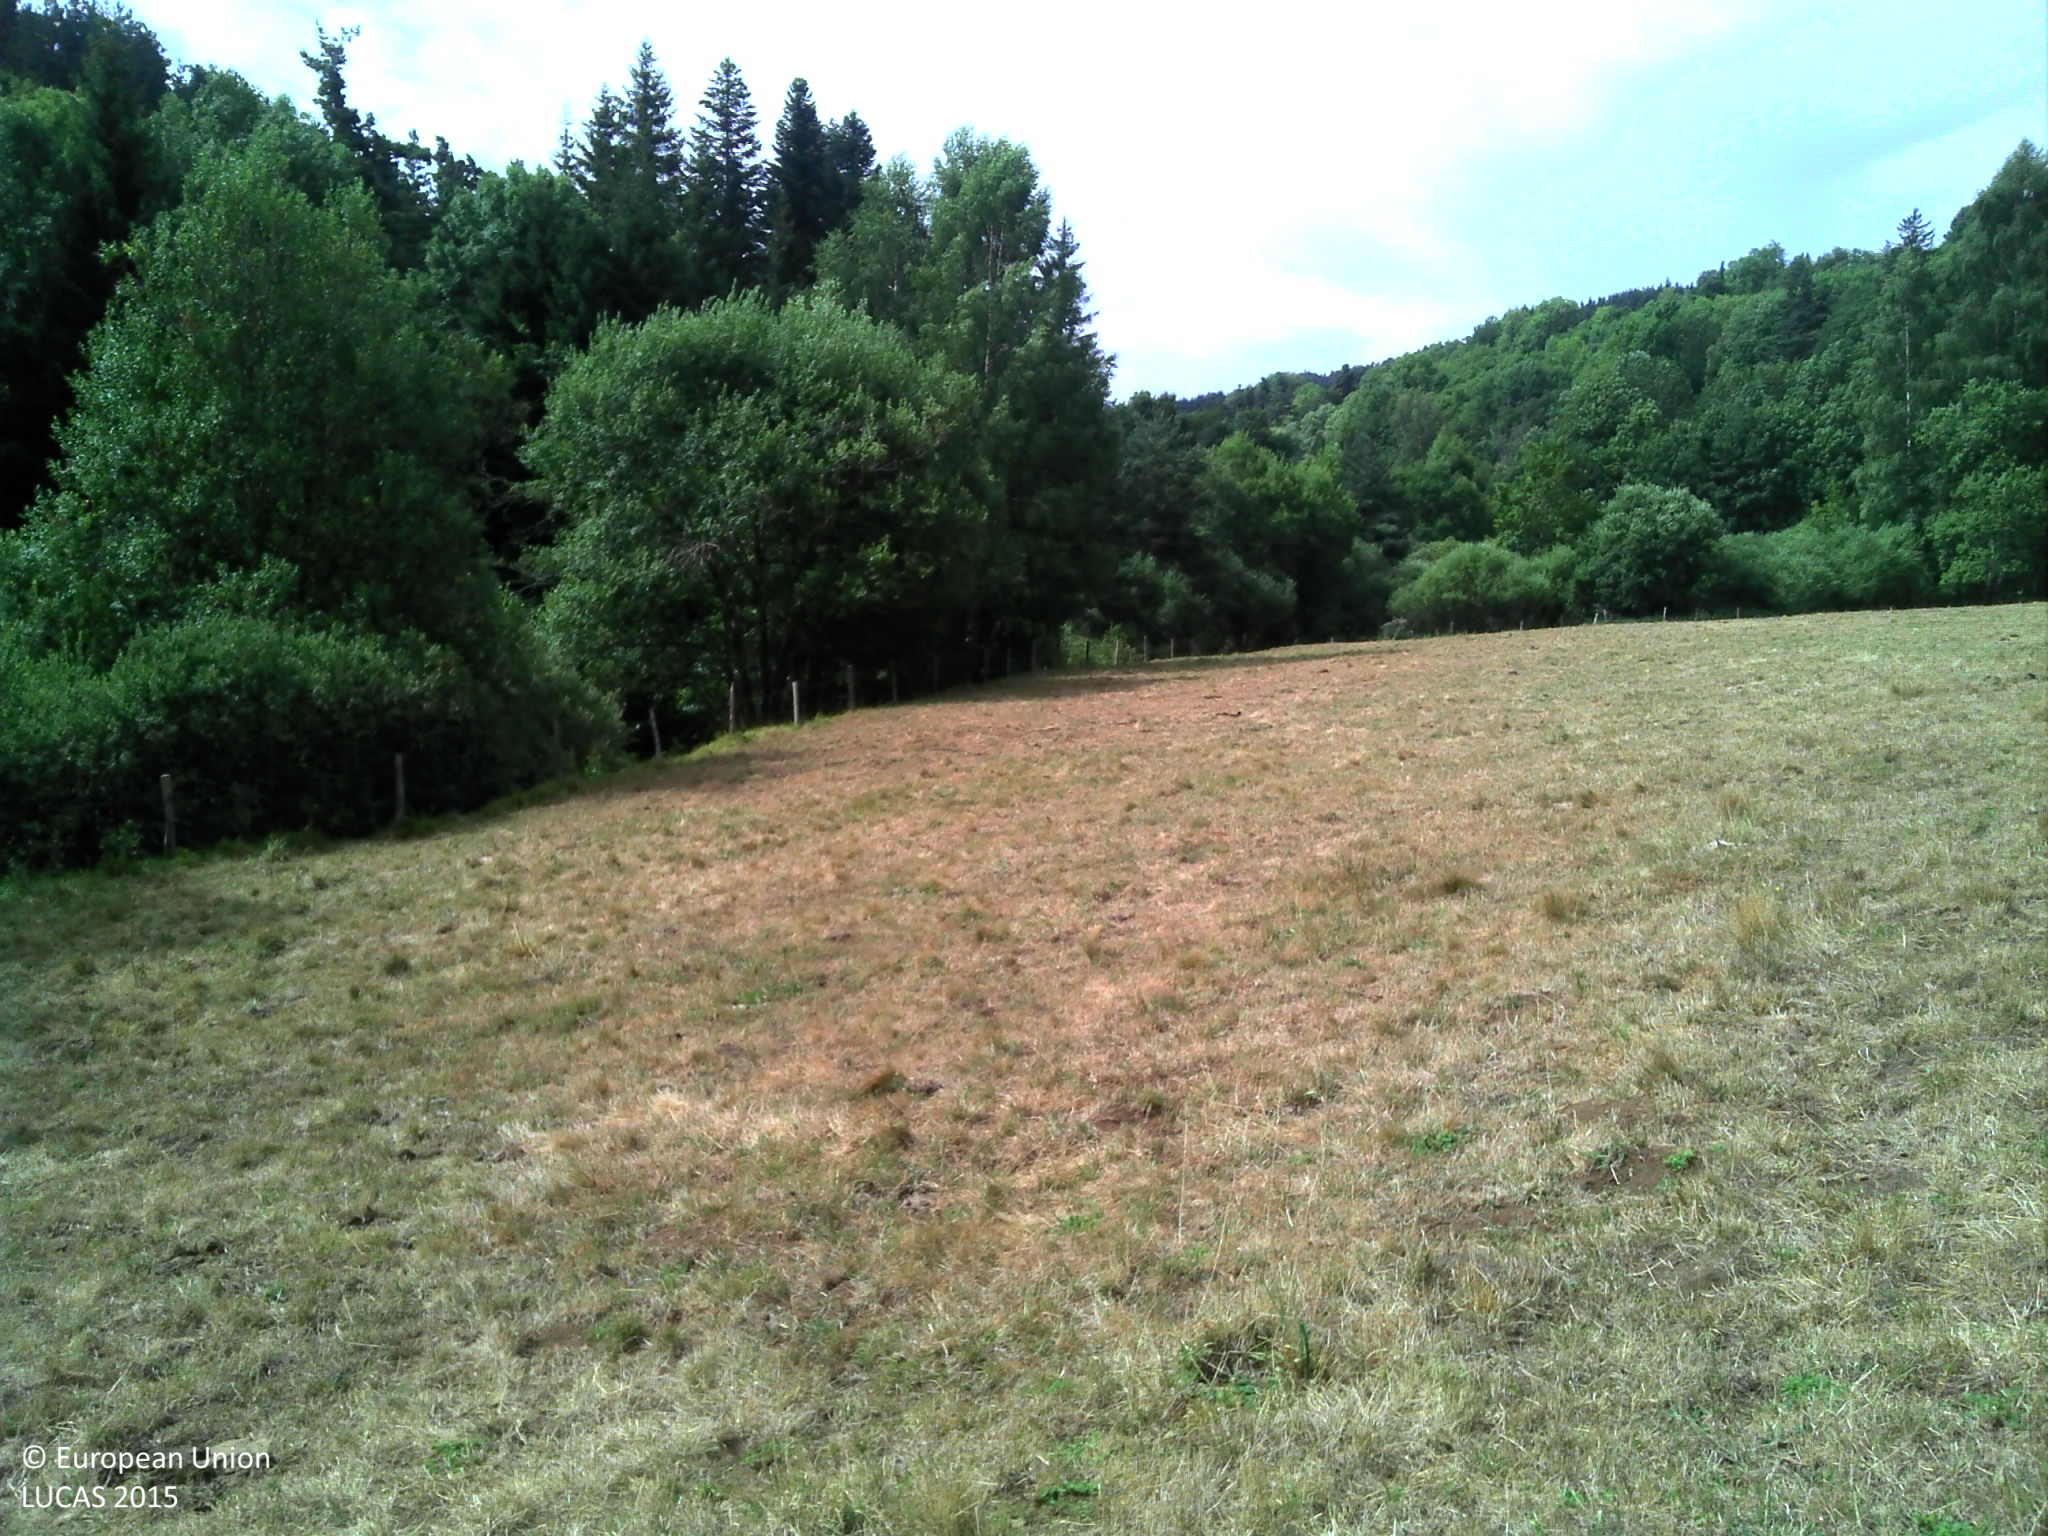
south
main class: Grassland
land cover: Grassland without tree/shrub cover
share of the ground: > 75 %
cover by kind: herbaceous plants 100 %
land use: Agriculture (excluding fallow land and kitchen gardens)
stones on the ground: < 10 %
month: July
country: FR
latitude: 44.7319
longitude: 3.9063
